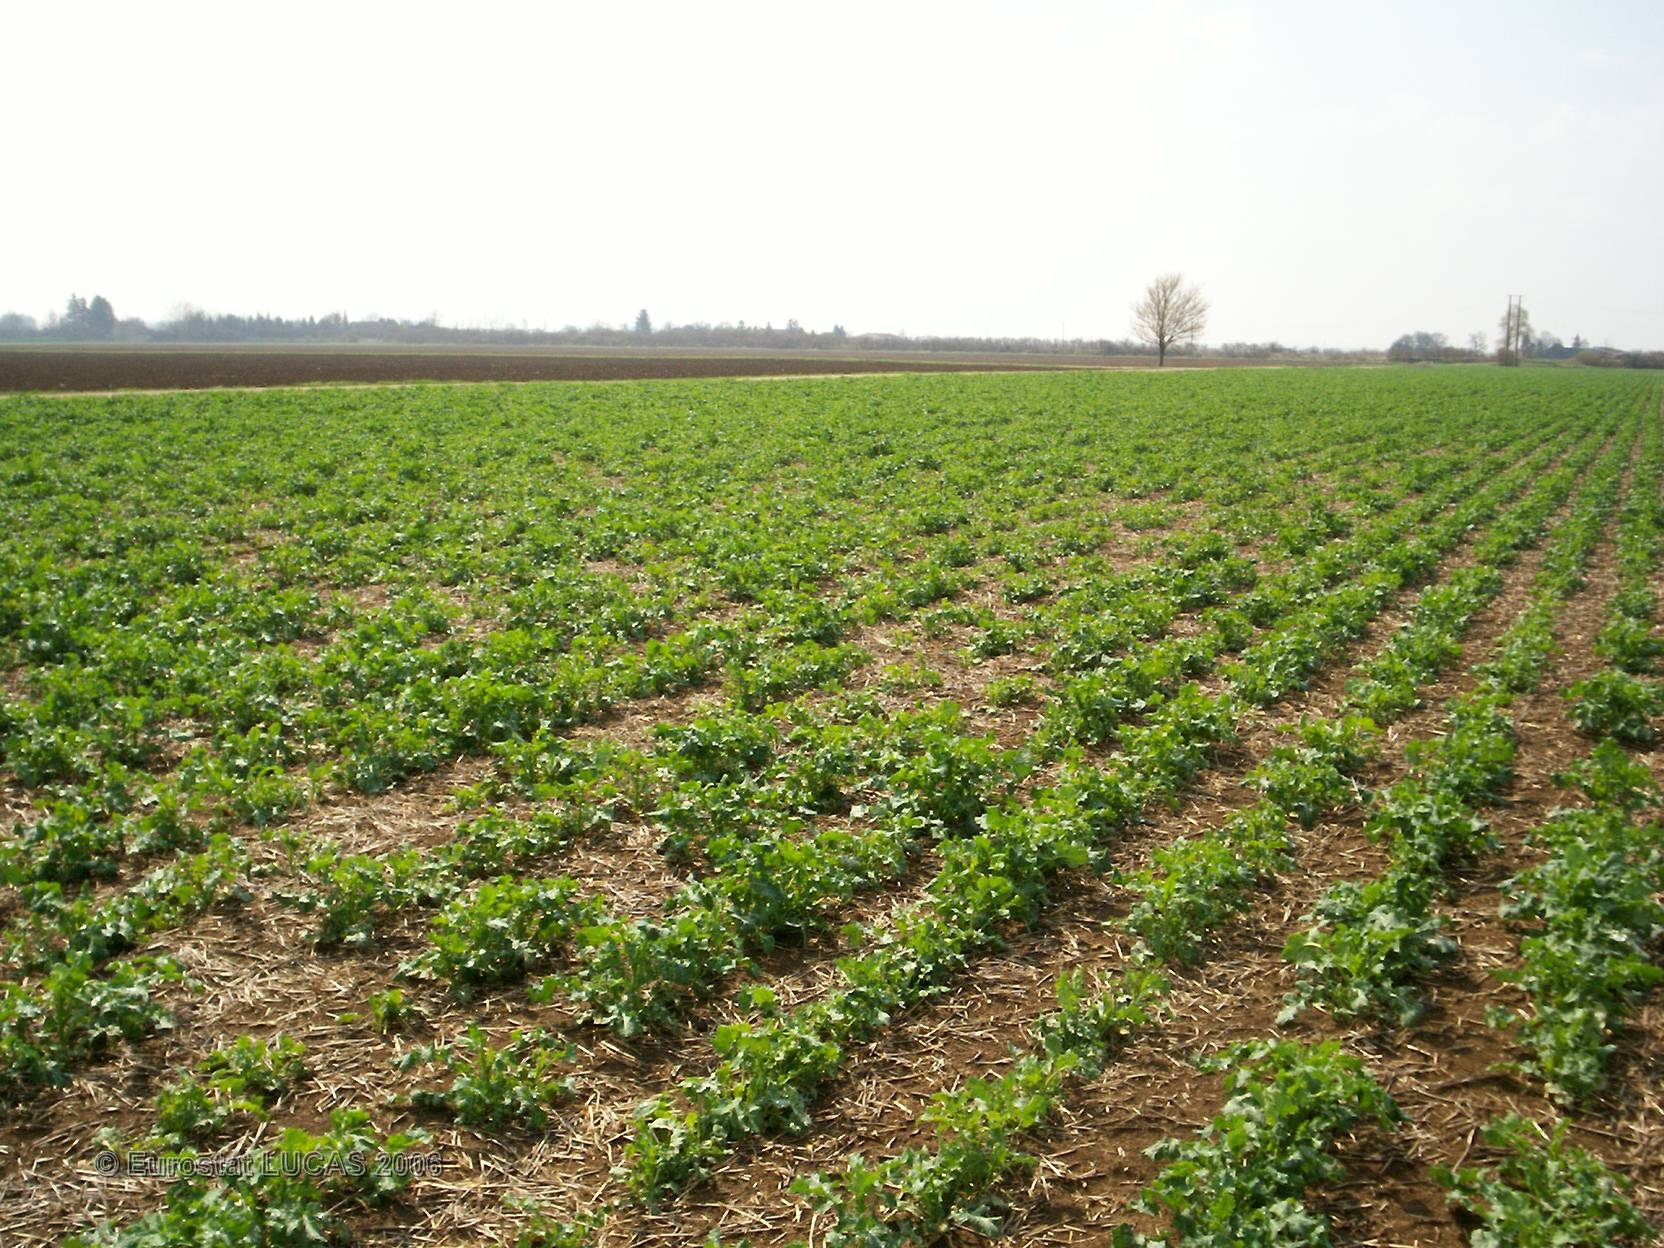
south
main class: Cropland
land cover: Sugar beet
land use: Agriculture (excluding fallow land and kitchen gardens)
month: April
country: FR
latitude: 46.9901
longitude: 5.3601
